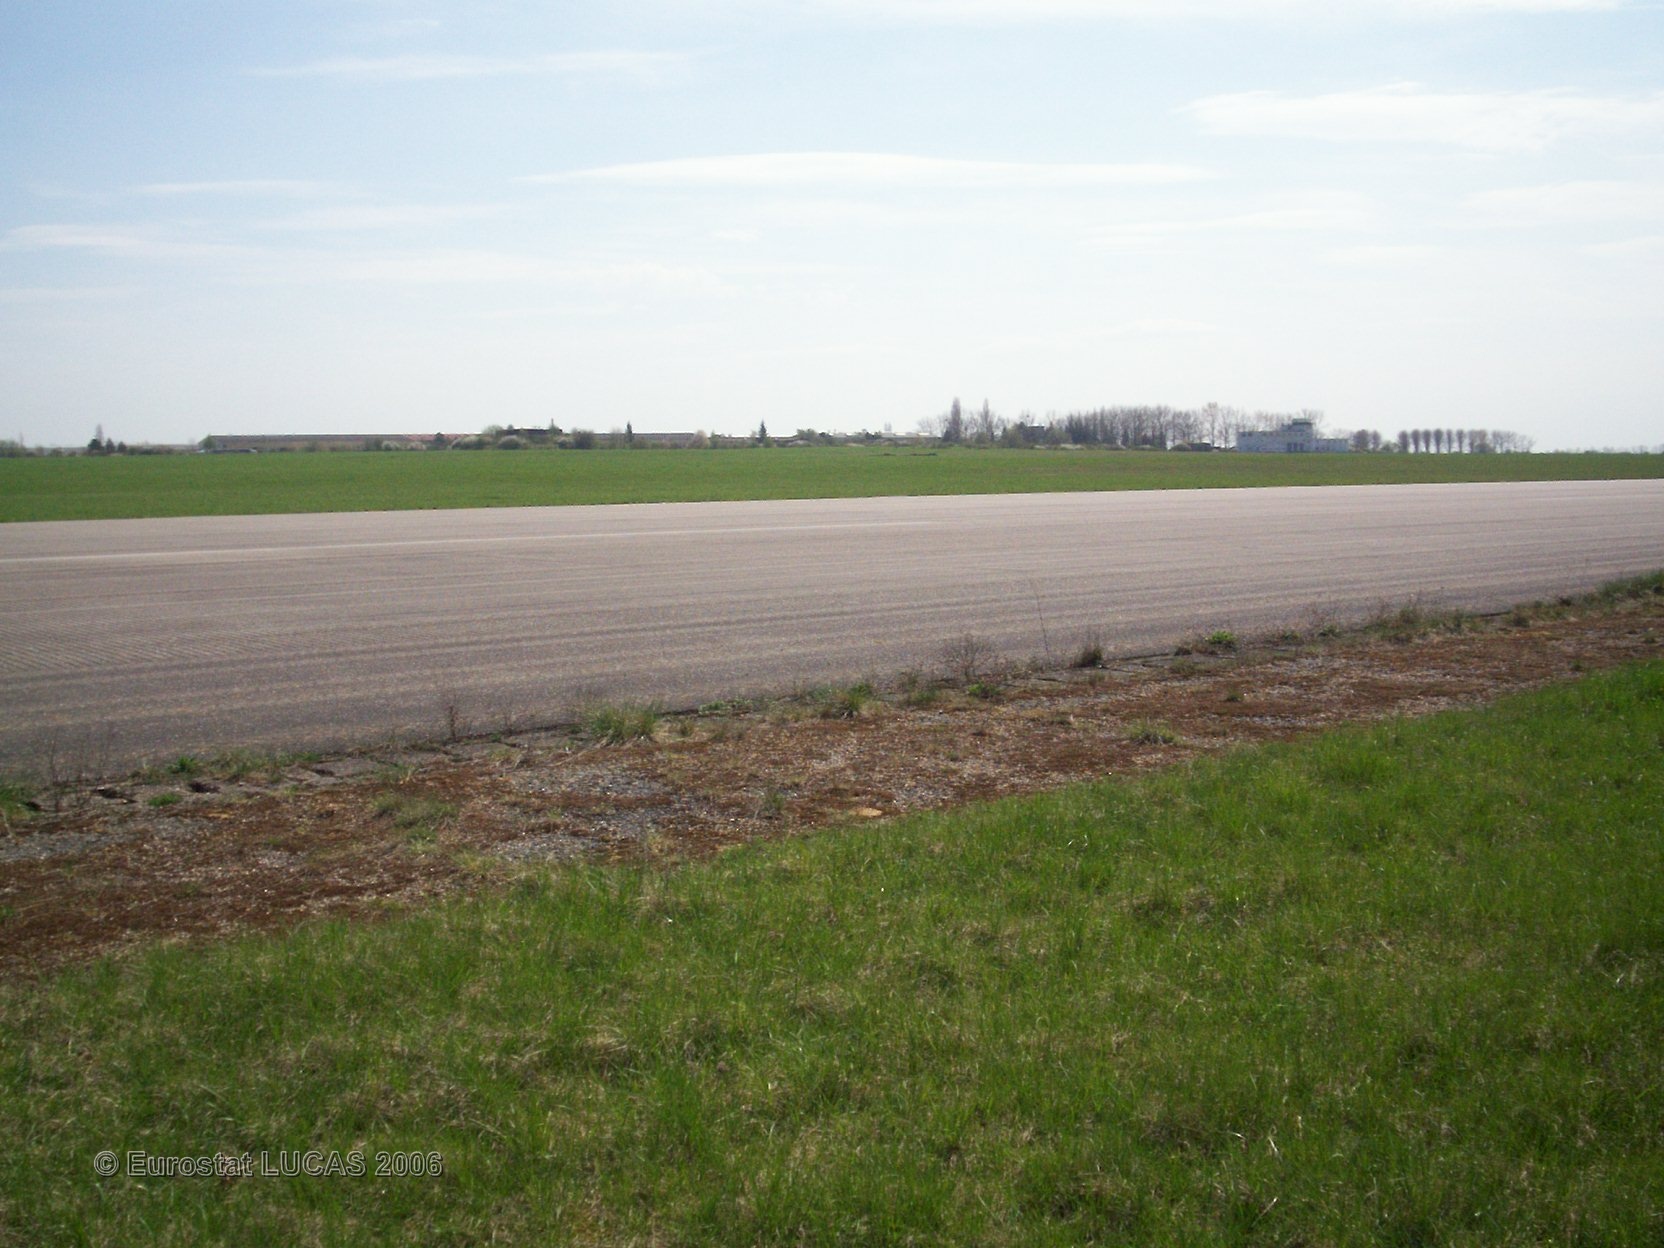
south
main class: Grassland
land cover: Grassland without tree/shrub cover
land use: Amenities, museums, leisure
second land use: Air transport
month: April
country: FR
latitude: 49.0294
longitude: 5.8827
